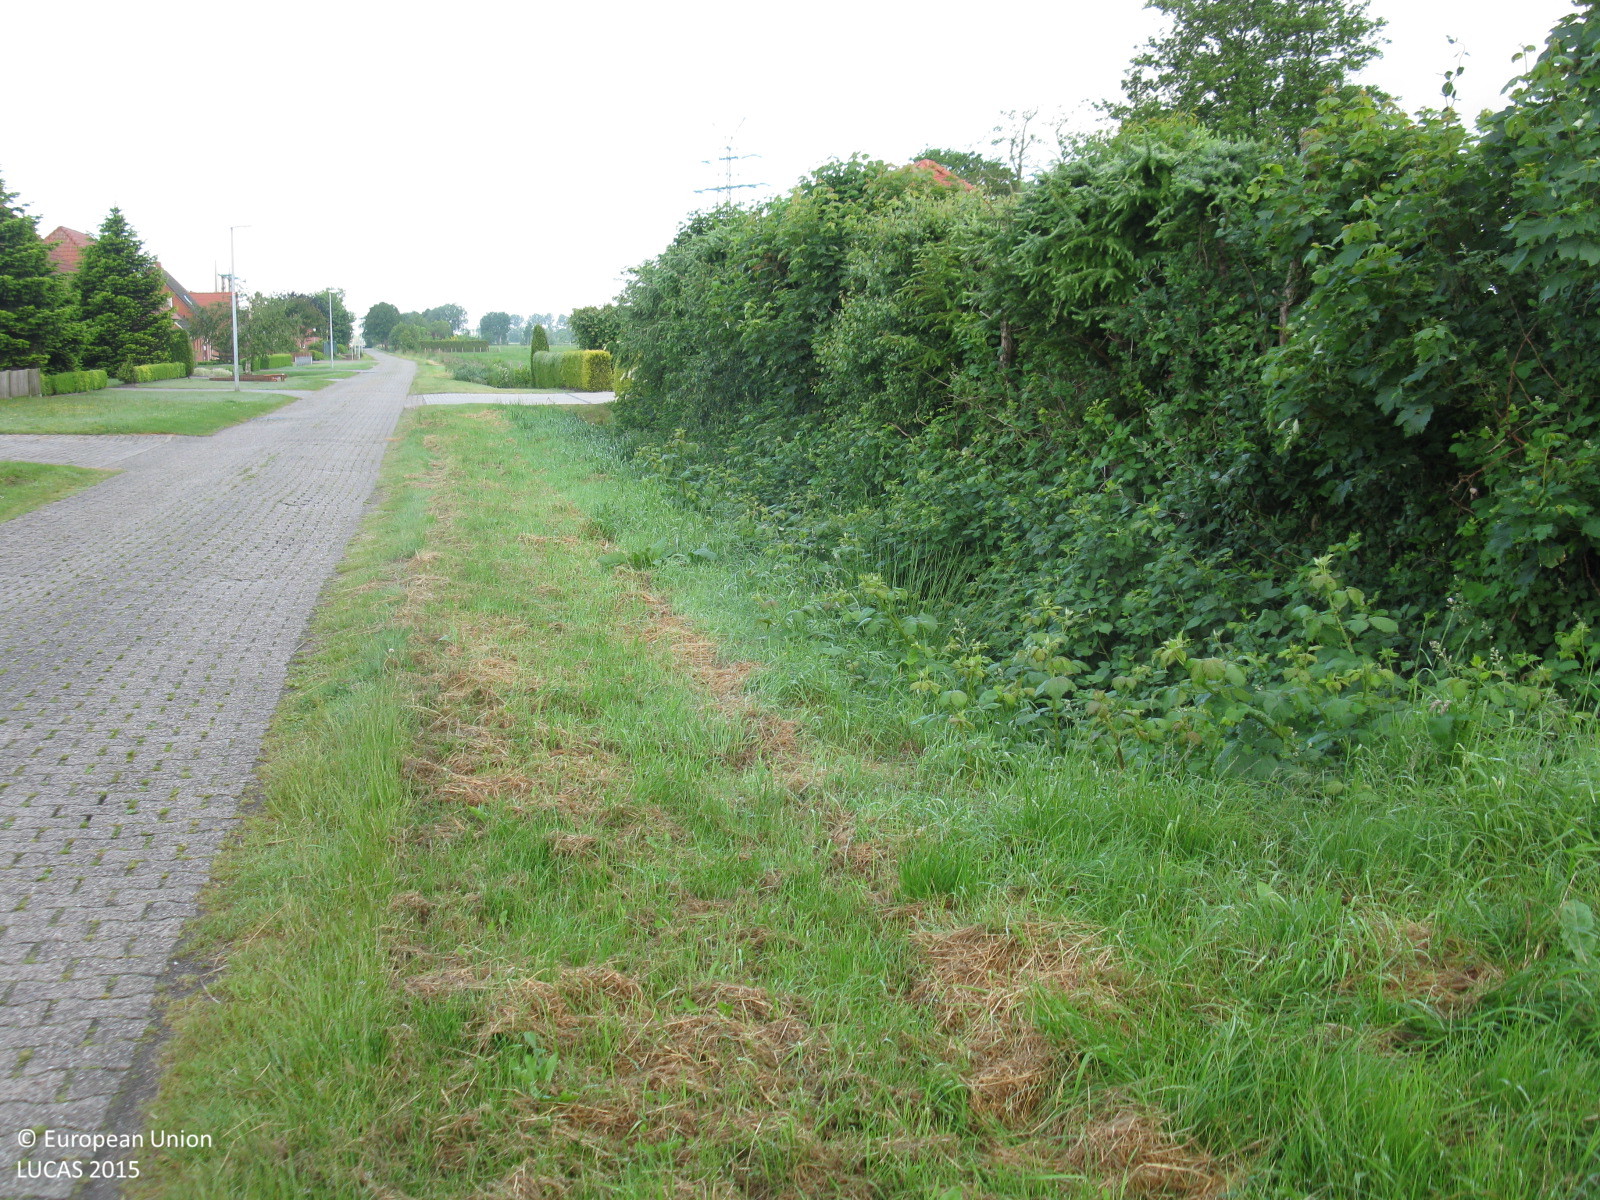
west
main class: Grassland
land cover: Grassland without tree/shrub cover
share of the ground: > 75 %
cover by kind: herbaceous plants 100 %
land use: Agriculture (excluding fallow land and kitchen gardens)
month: June
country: DE
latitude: 53.5337
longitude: 7.3000
